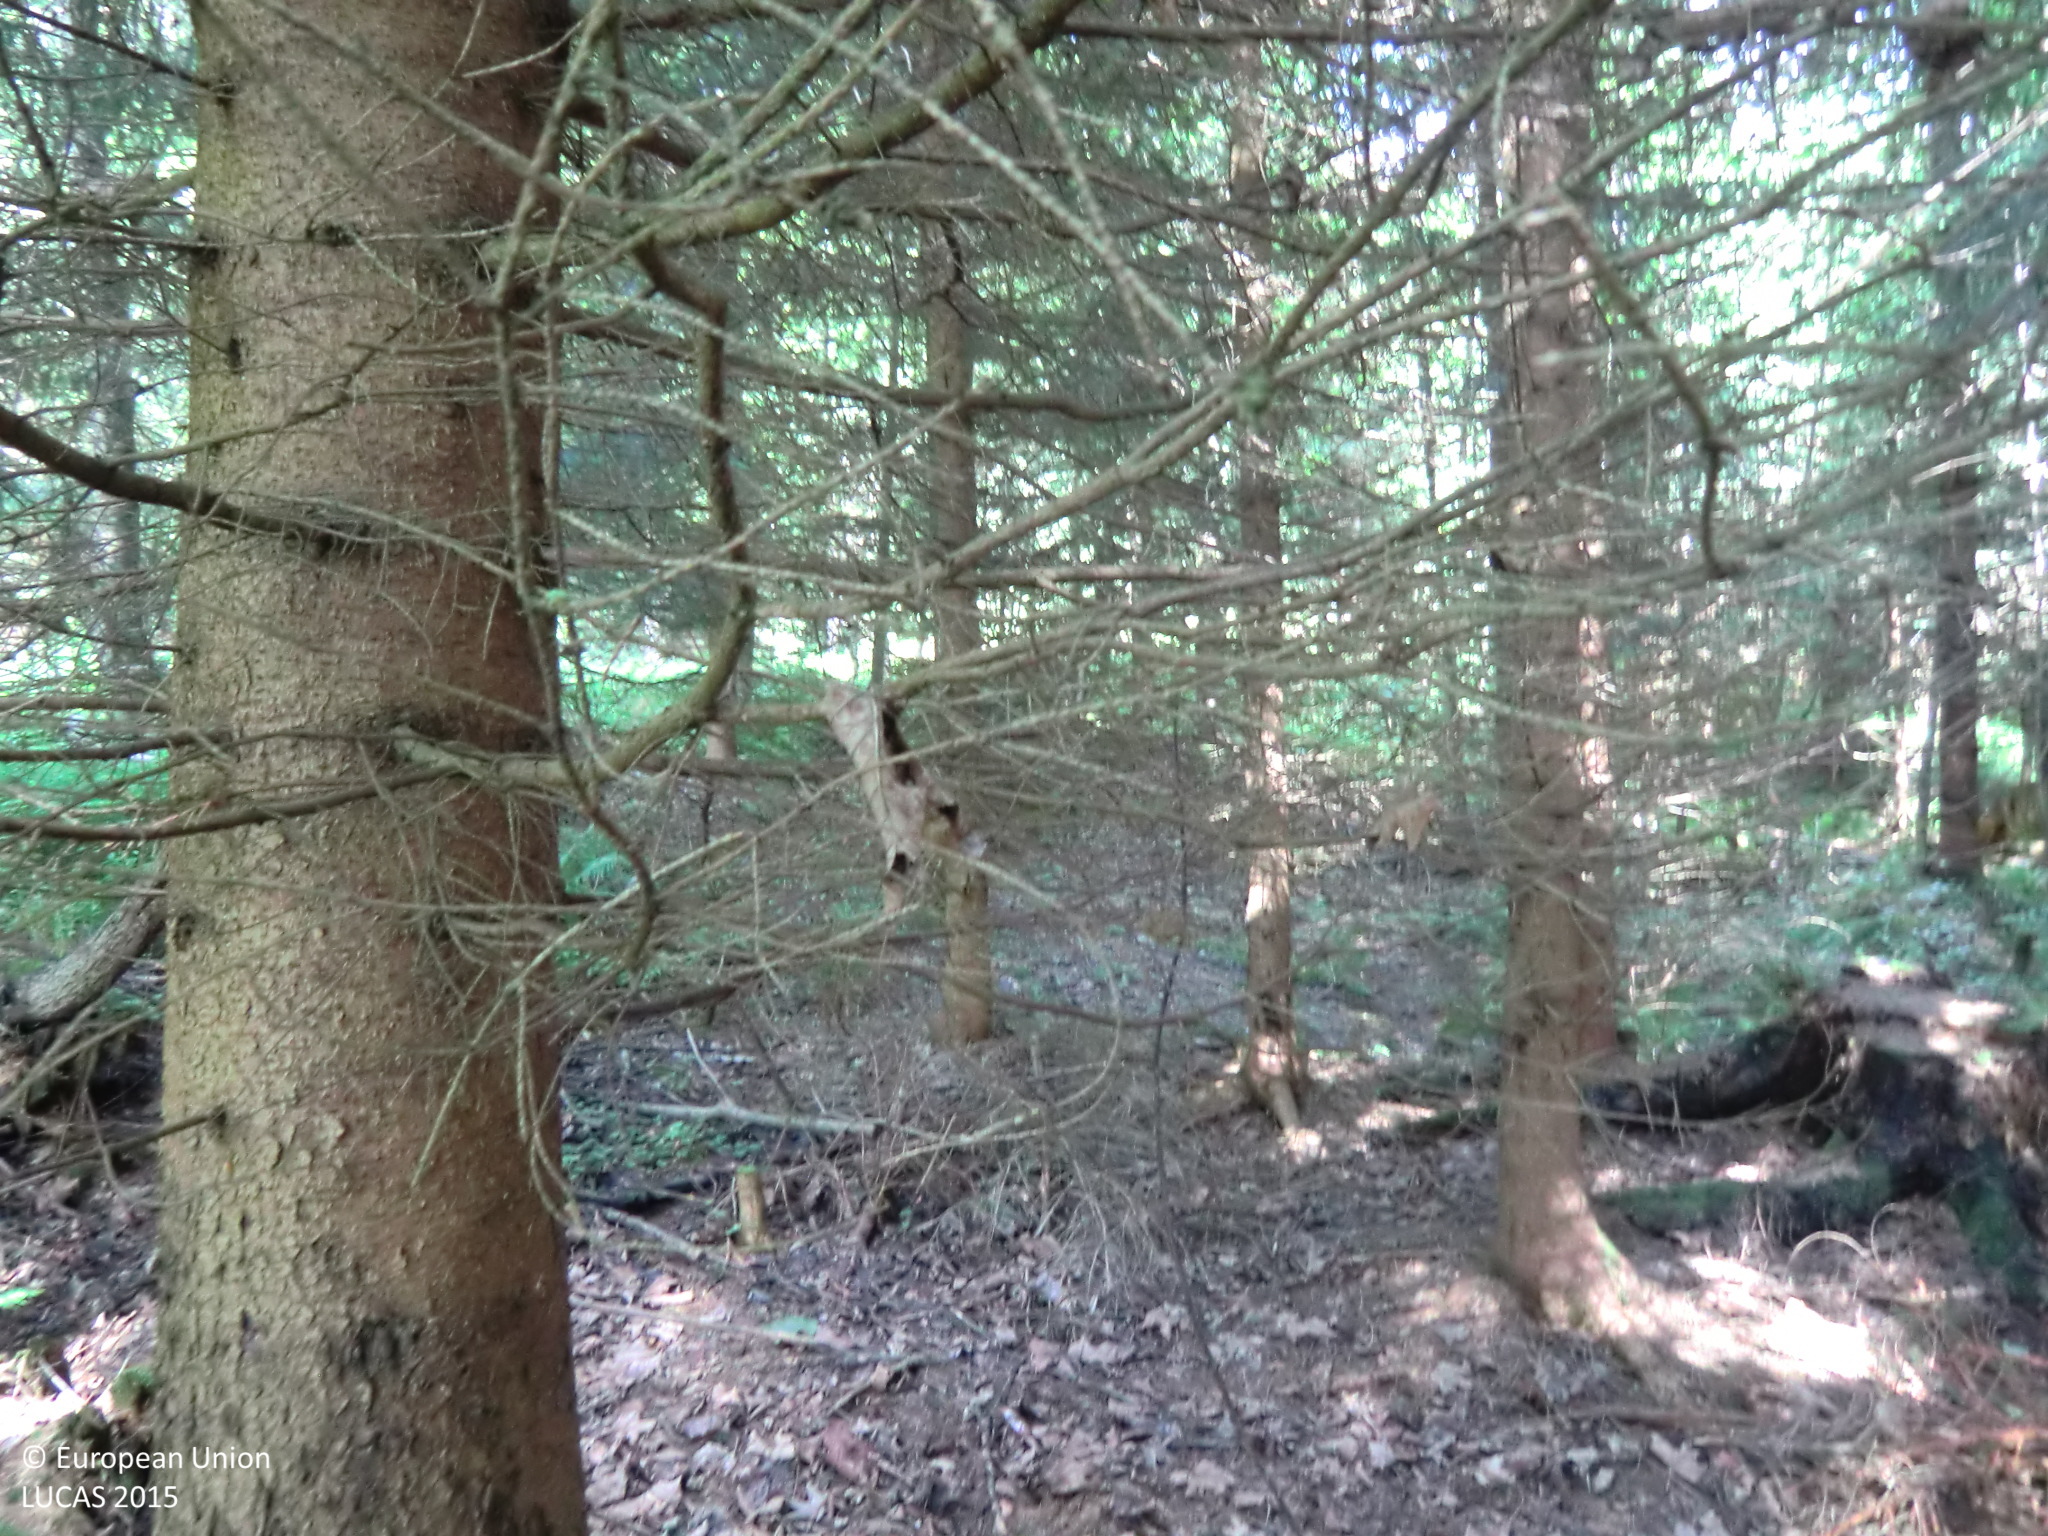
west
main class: Woodland
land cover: Spruce dominated coniferous woodland
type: hemiboreal forest and nemoral coniferous forest and mixed broadleaved-coniferous forest
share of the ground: > 75 %
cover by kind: coniferous forest trees 90 %, broadleaved forest trees 10 %
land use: Forestry
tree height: > 5 m
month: June
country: AT
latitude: 48.4770
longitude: 14.8577
